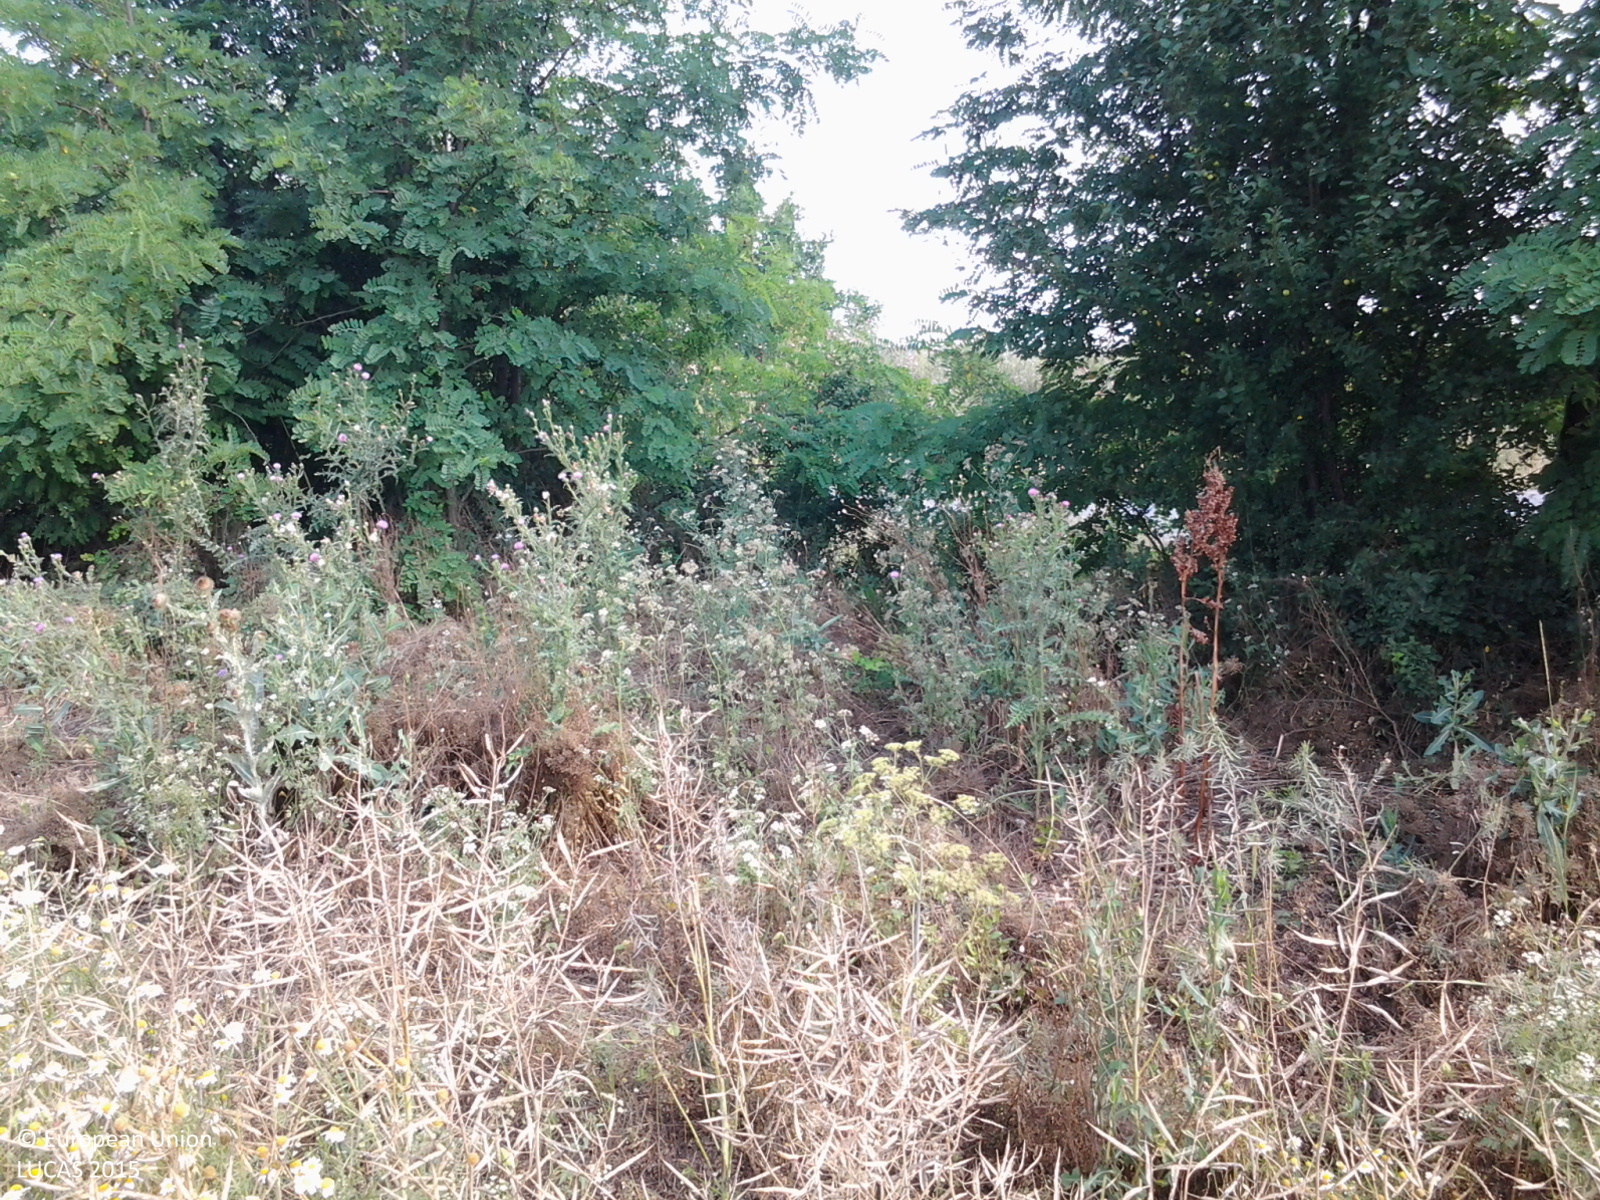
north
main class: Cropland
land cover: Rape and turnip rape
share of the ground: 50 - 75 %
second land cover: Spontaneously vegetated surfaces
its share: 25 - 50 %
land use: Agriculture (excluding fallow land and kitchen gardens)
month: July
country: HU
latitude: 47.0015
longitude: 20.4310
